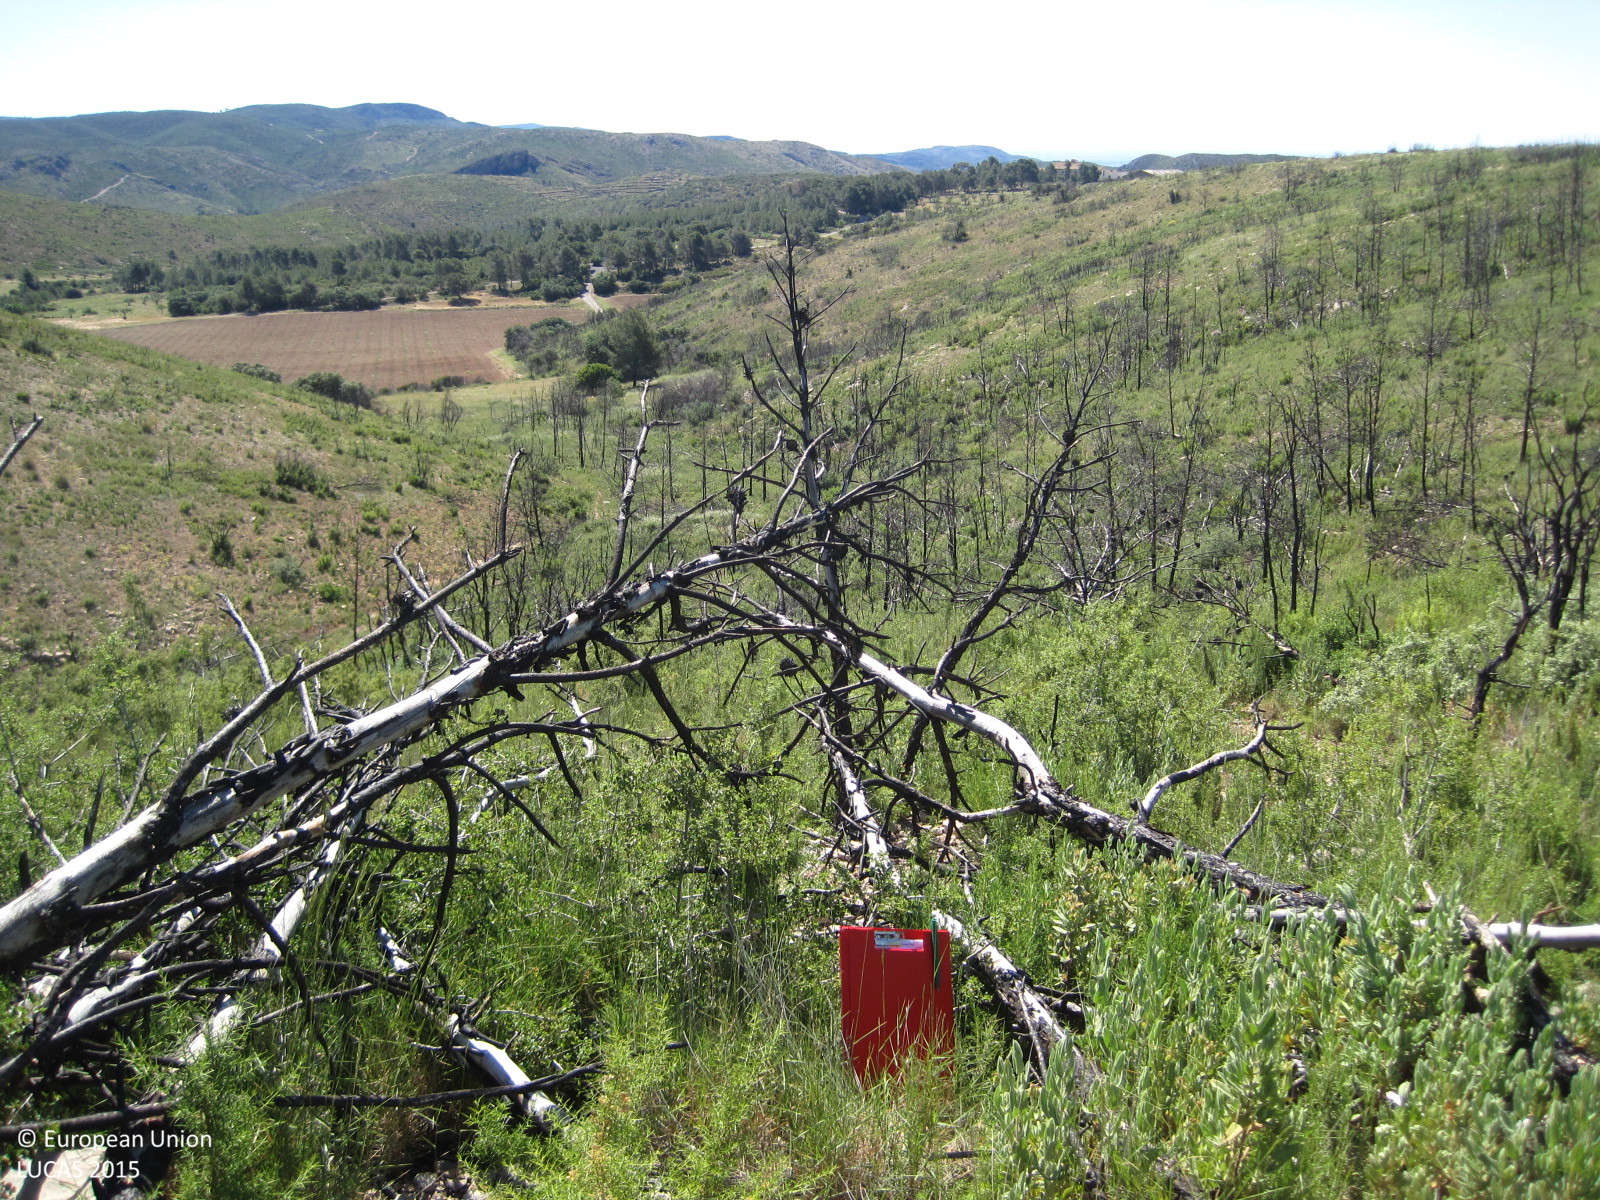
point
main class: Shrubland
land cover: Shrubland without tree cover
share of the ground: 50 - 75 %
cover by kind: shrubs 60 %, herbaceous plants 20 %, consolidated bare surface 20 %
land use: Semi-natural and natural areas not in use
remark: Burnt area
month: May
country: ES
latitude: 39.7963
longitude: -0.6413
